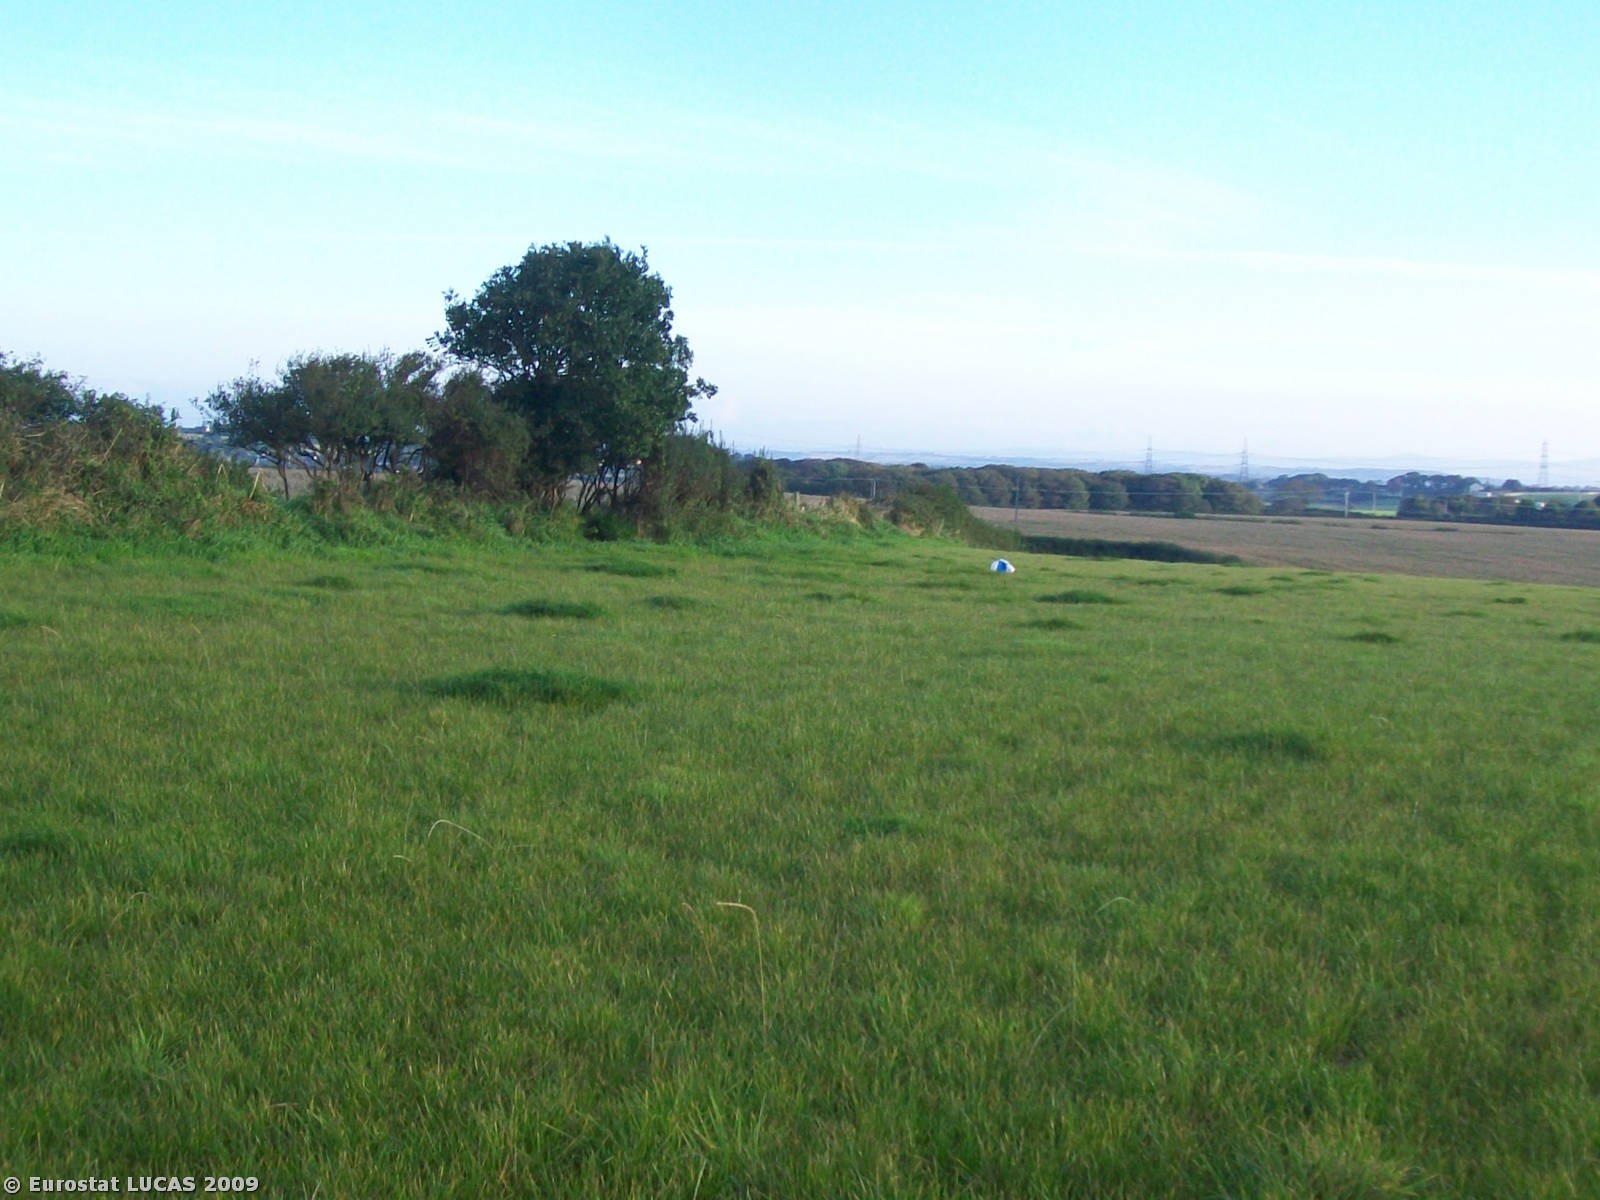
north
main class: Grassland
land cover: Grassland without tree/shrub cover
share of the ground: > 75 %
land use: Agriculture (excluding fallow land and kitchen gardens)
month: September
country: GB
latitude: 51.6457
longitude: -4.9284
